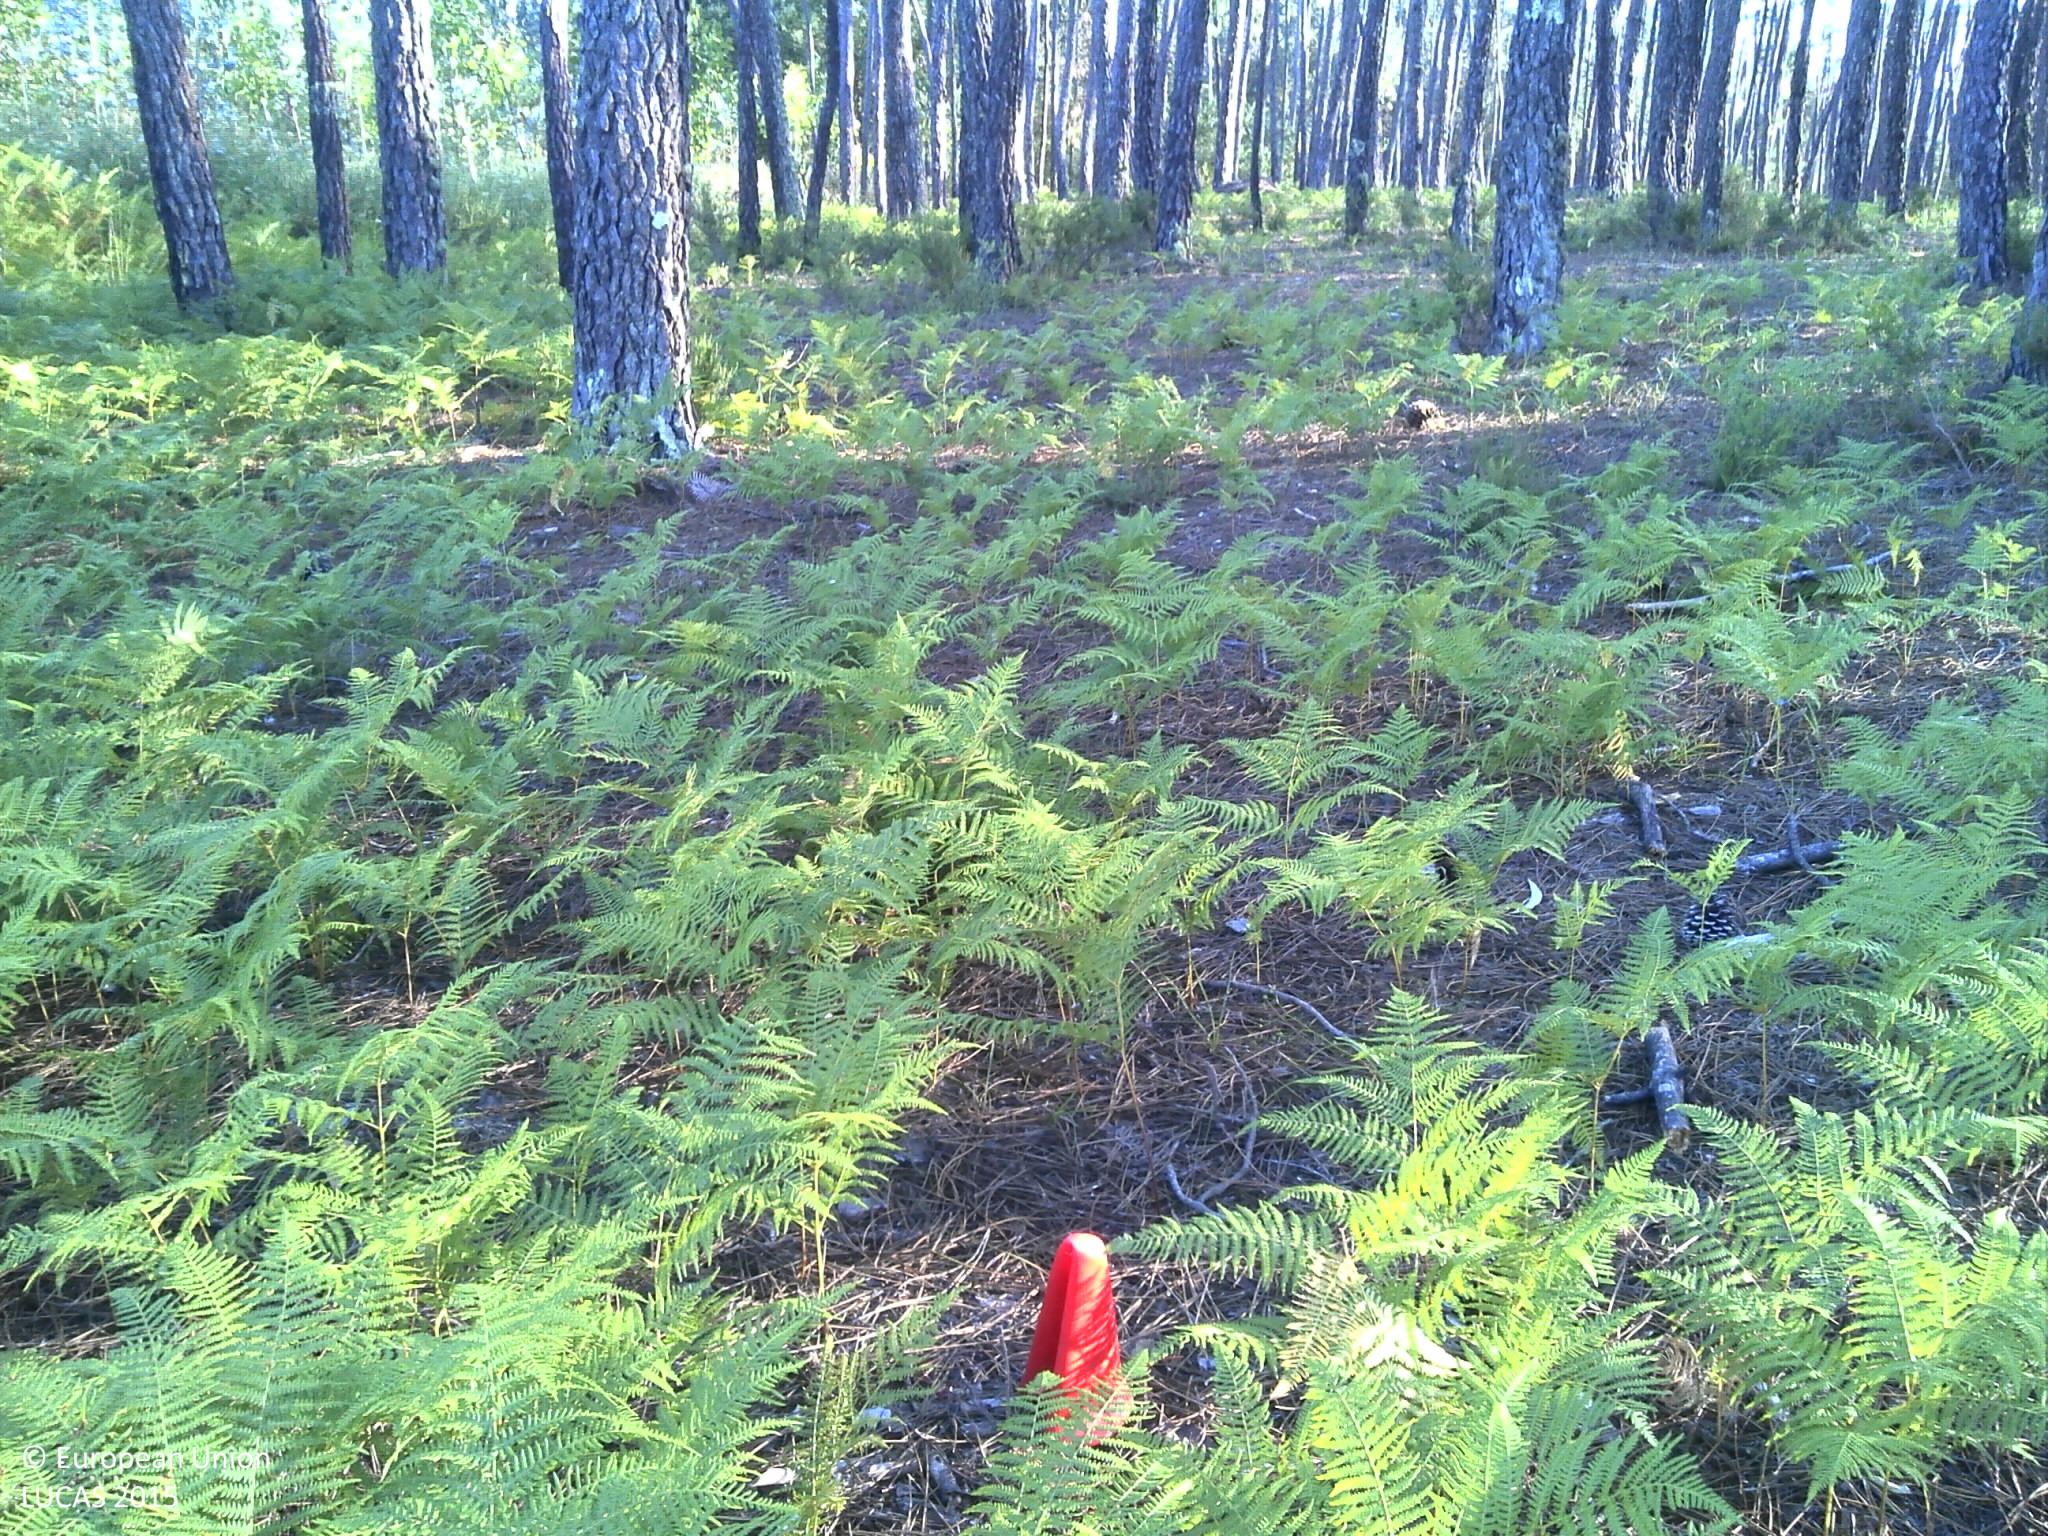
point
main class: Woodland
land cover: Pine dominated coniferous woodland
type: coniferous forest of the mediterranean region
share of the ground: 50 - 75 %
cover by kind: coniferous forest trees 75 %, shrubs 10 %, herbaceous plants 10 %, unconsolidated bare surface 5 %
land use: Forestry
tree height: > 5 m
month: May
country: PT
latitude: 40.4169
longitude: -8.6798
